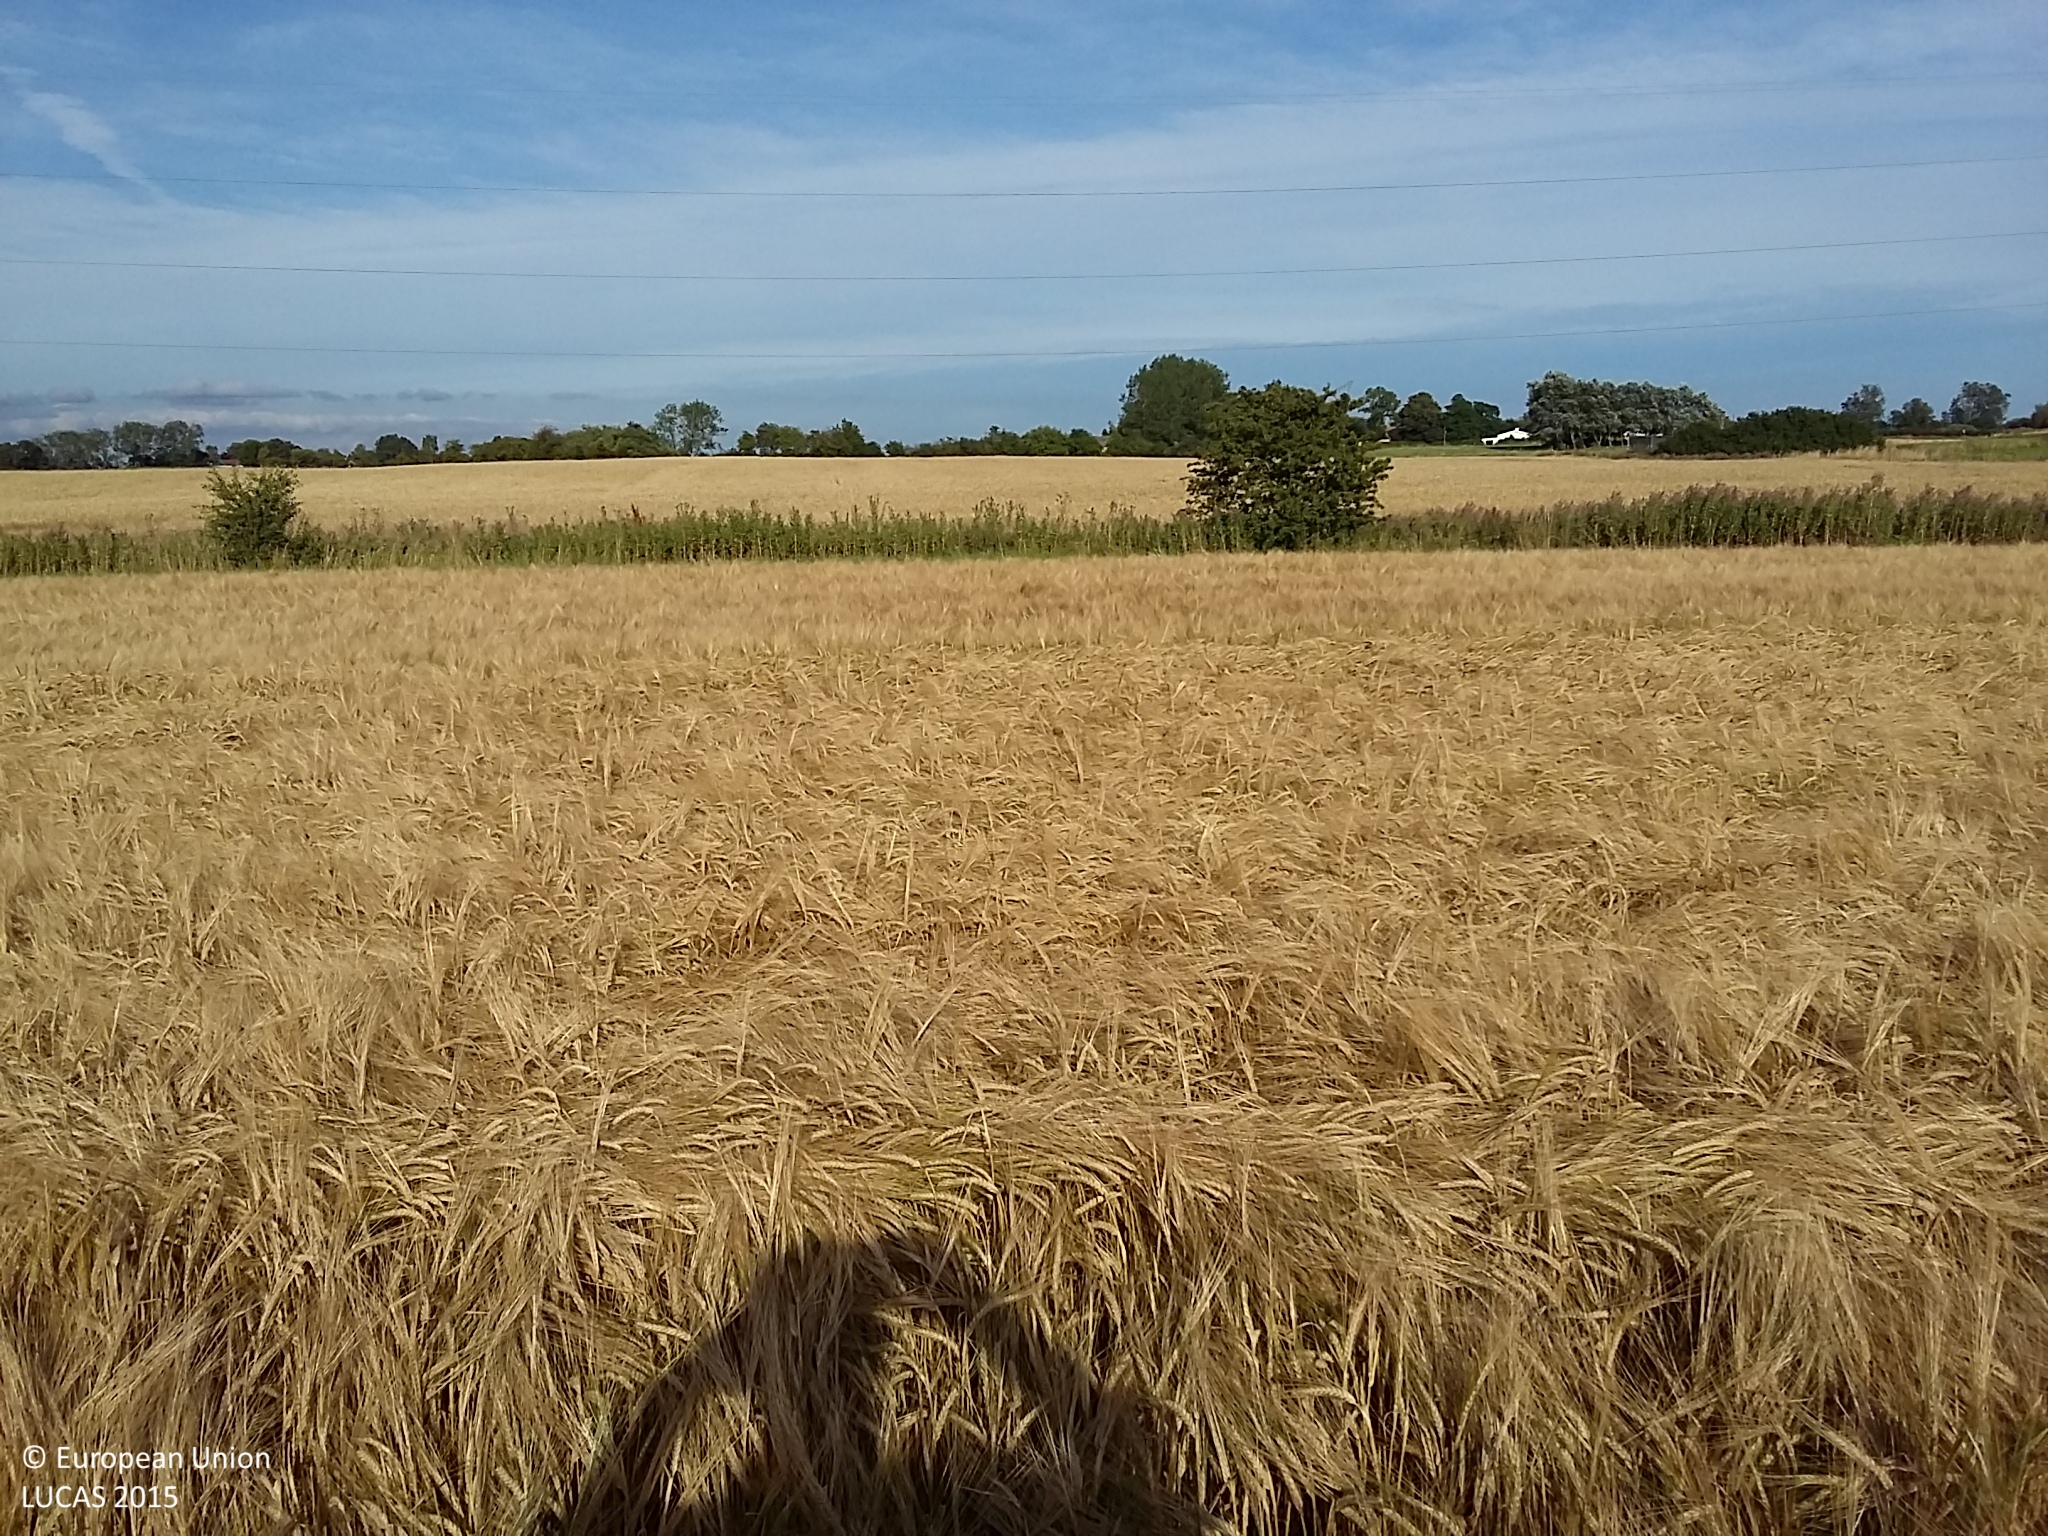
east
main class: Cropland
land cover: Barley
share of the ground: > 75 %
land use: Agriculture (excluding fallow land and kitchen gardens)
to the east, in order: Barley; Grassland without tree/shrub cover; Shruby margins; Ditches and canals; Grass margins; Fences; Grassland without tree/shrub cover; Fences; Common wheat; Electric lines; Common wheat
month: August
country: DK
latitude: 55.5242
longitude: 12.0417
